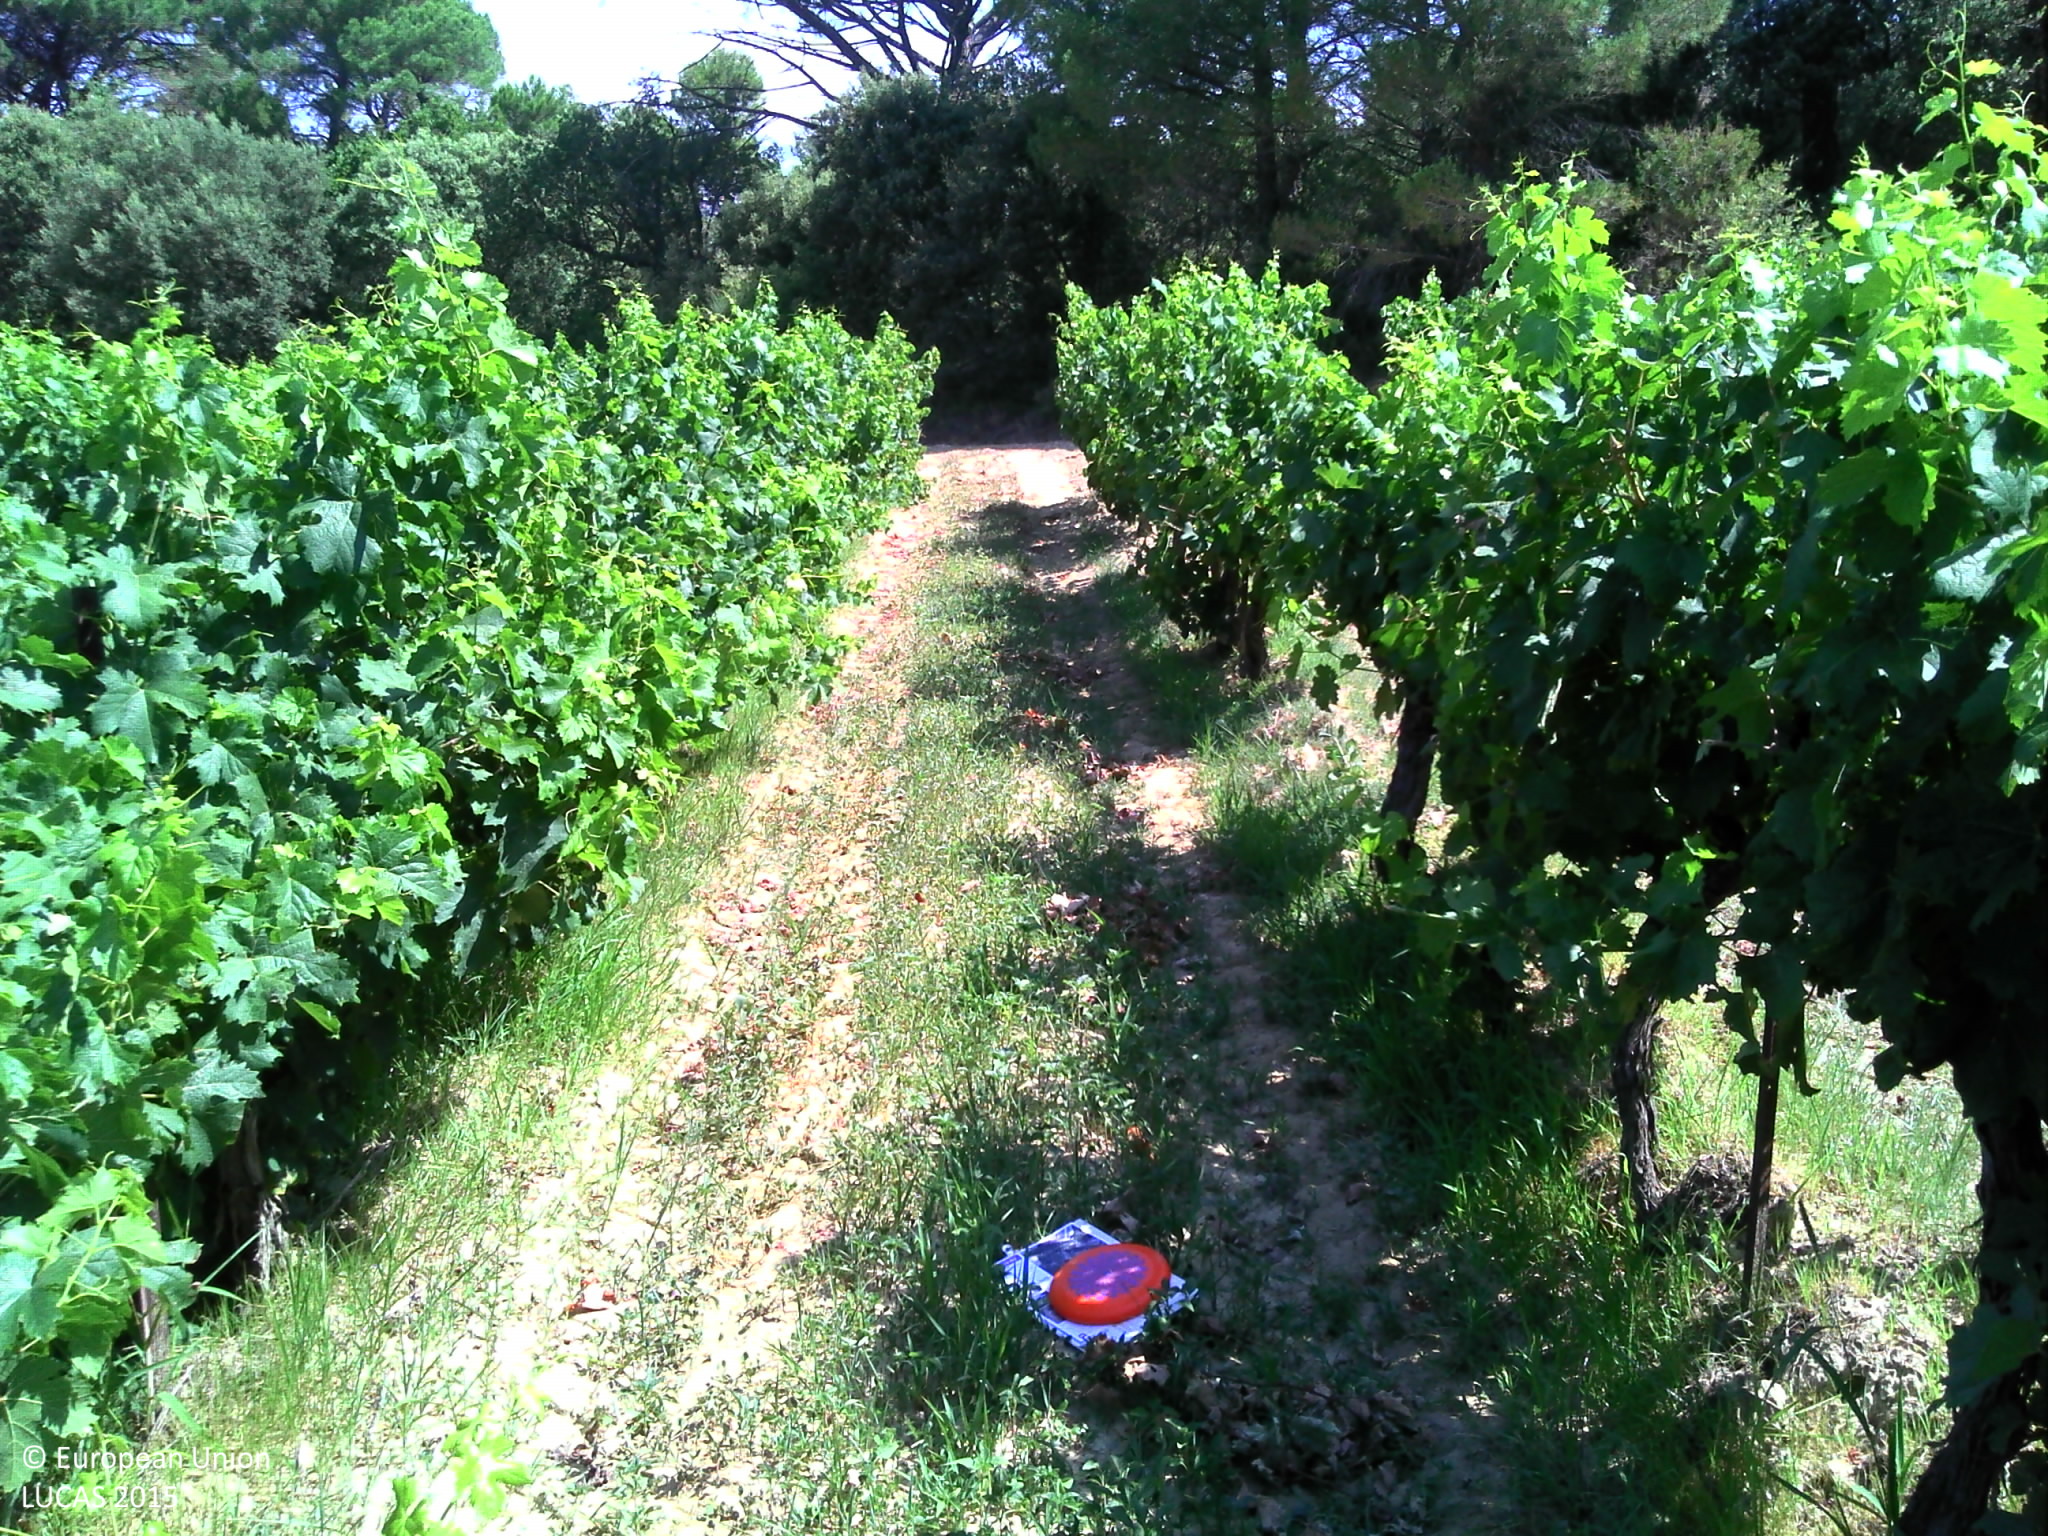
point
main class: Cropland
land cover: Vineyards
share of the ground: 25 - 50 %
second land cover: Grassland without tree/shrub cover
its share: 50 - 75 %
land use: Agriculture (excluding fallow land and kitchen gardens)
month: July
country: FR
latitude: 43.7144
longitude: 5.5781
